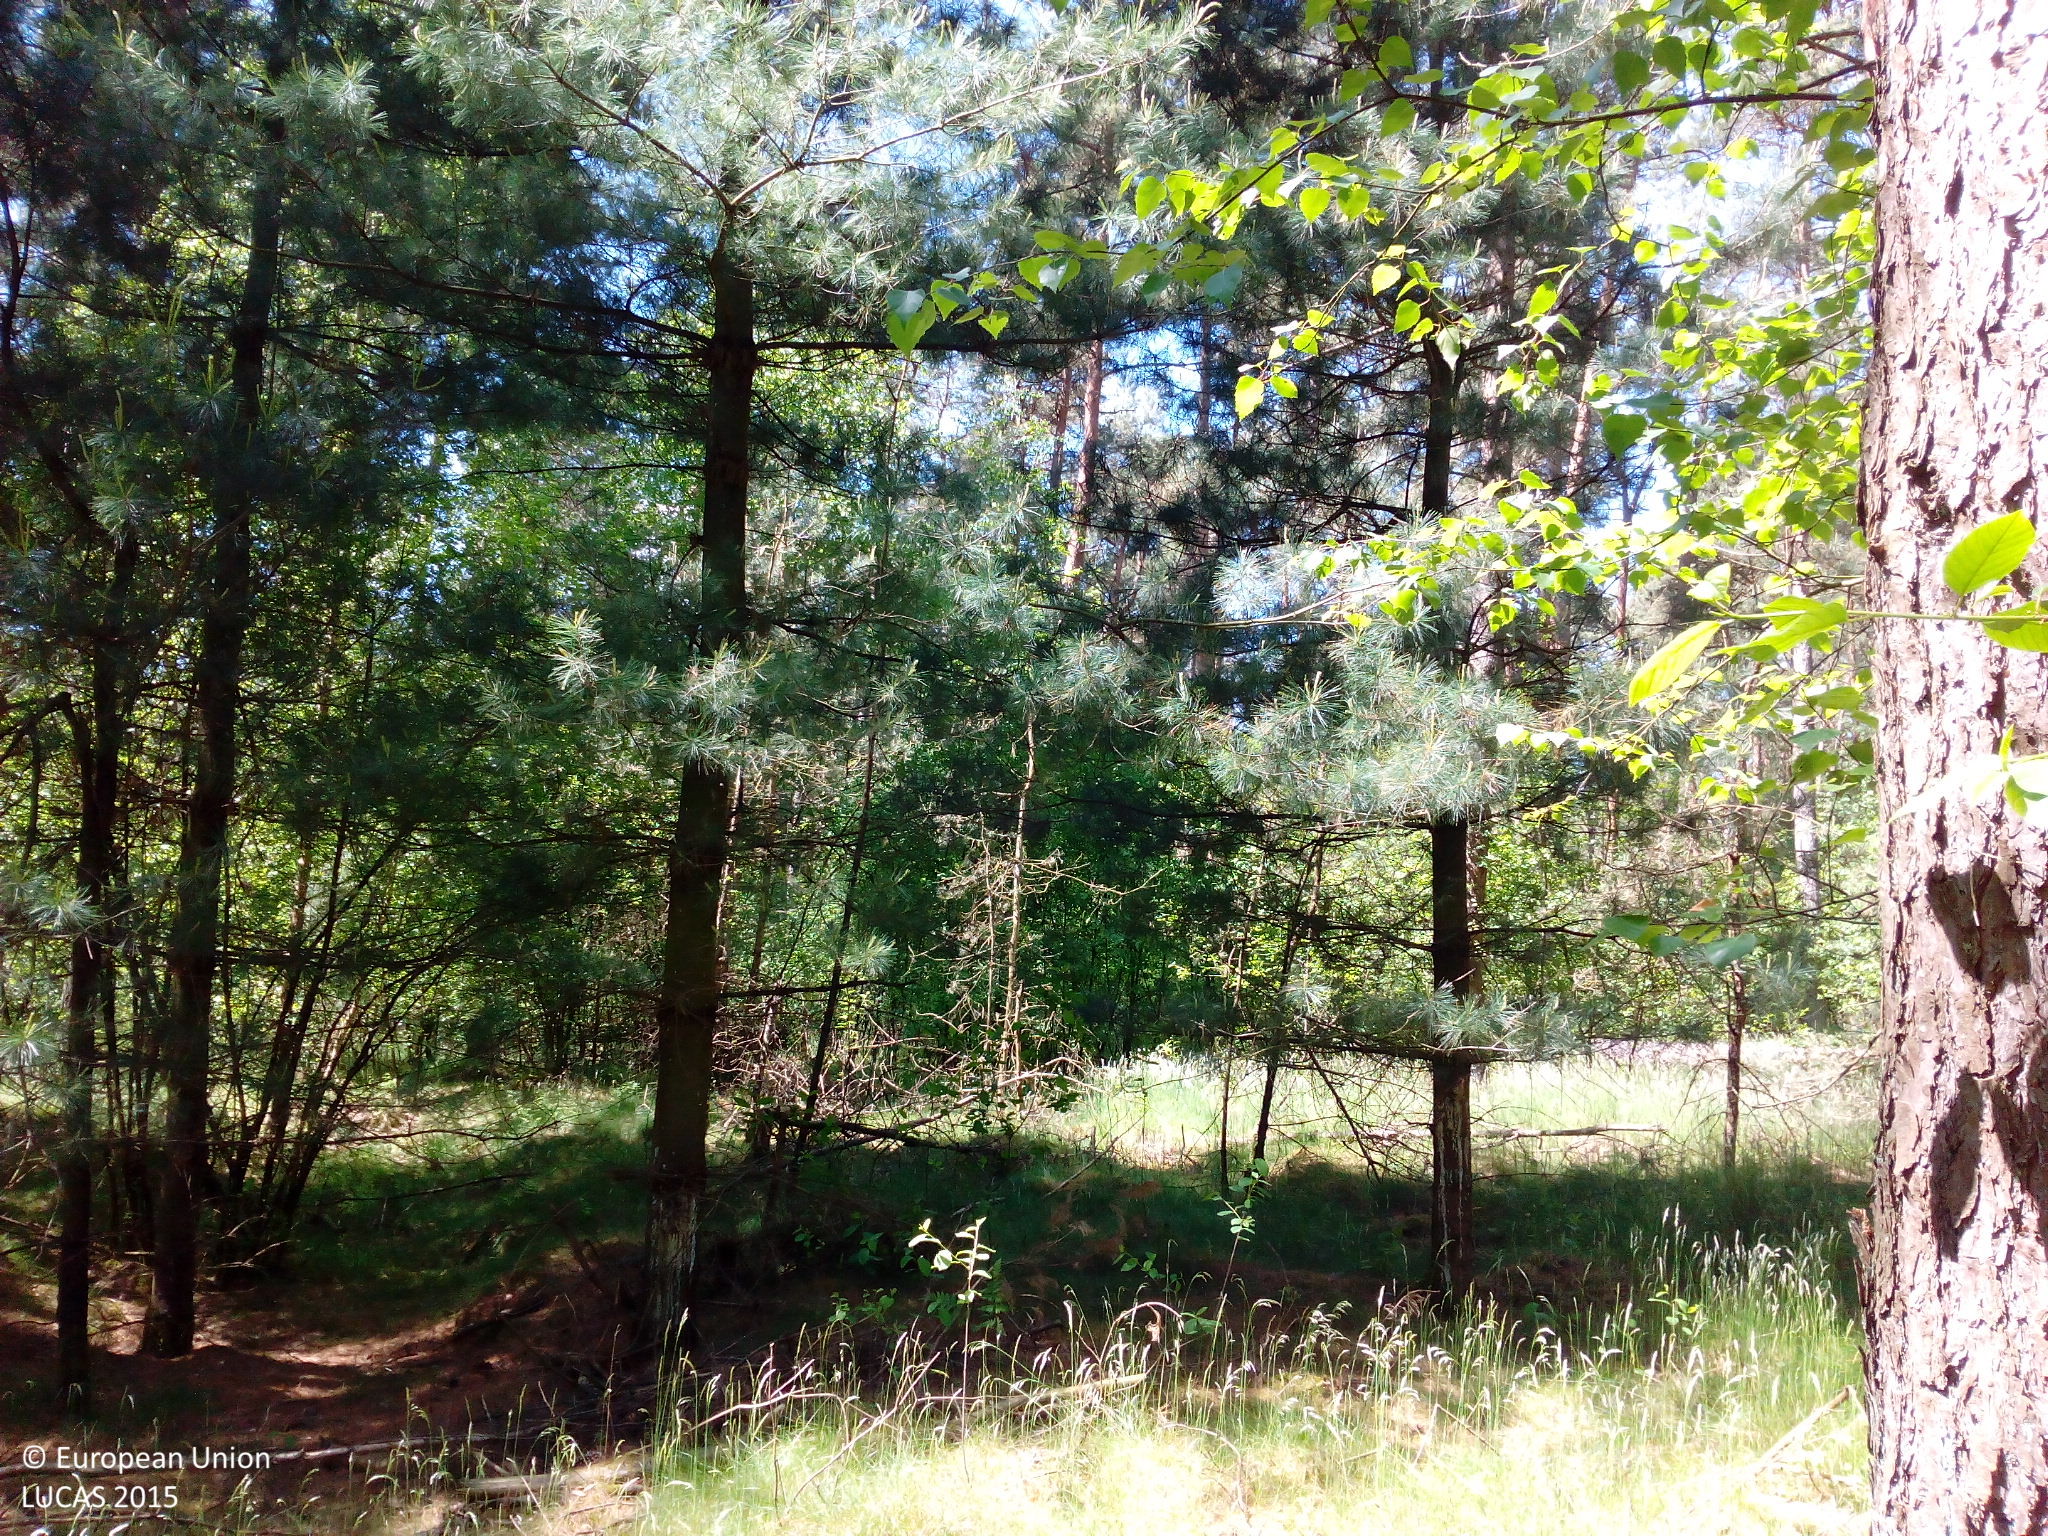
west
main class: Woodland
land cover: Pine dominated mixed woodland
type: hemiboreal forest and nemoral coniferous forest and mixed broadleaved-coniferous forest
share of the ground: > 75 %
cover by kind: coniferous forest trees 45 %, broadleaved forest trees 45 %, shrubs 5 %, herbaceous plants 5 %
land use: Forestry
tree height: > 5 m
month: June
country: DE
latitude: 52.4023
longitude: 7.3694
